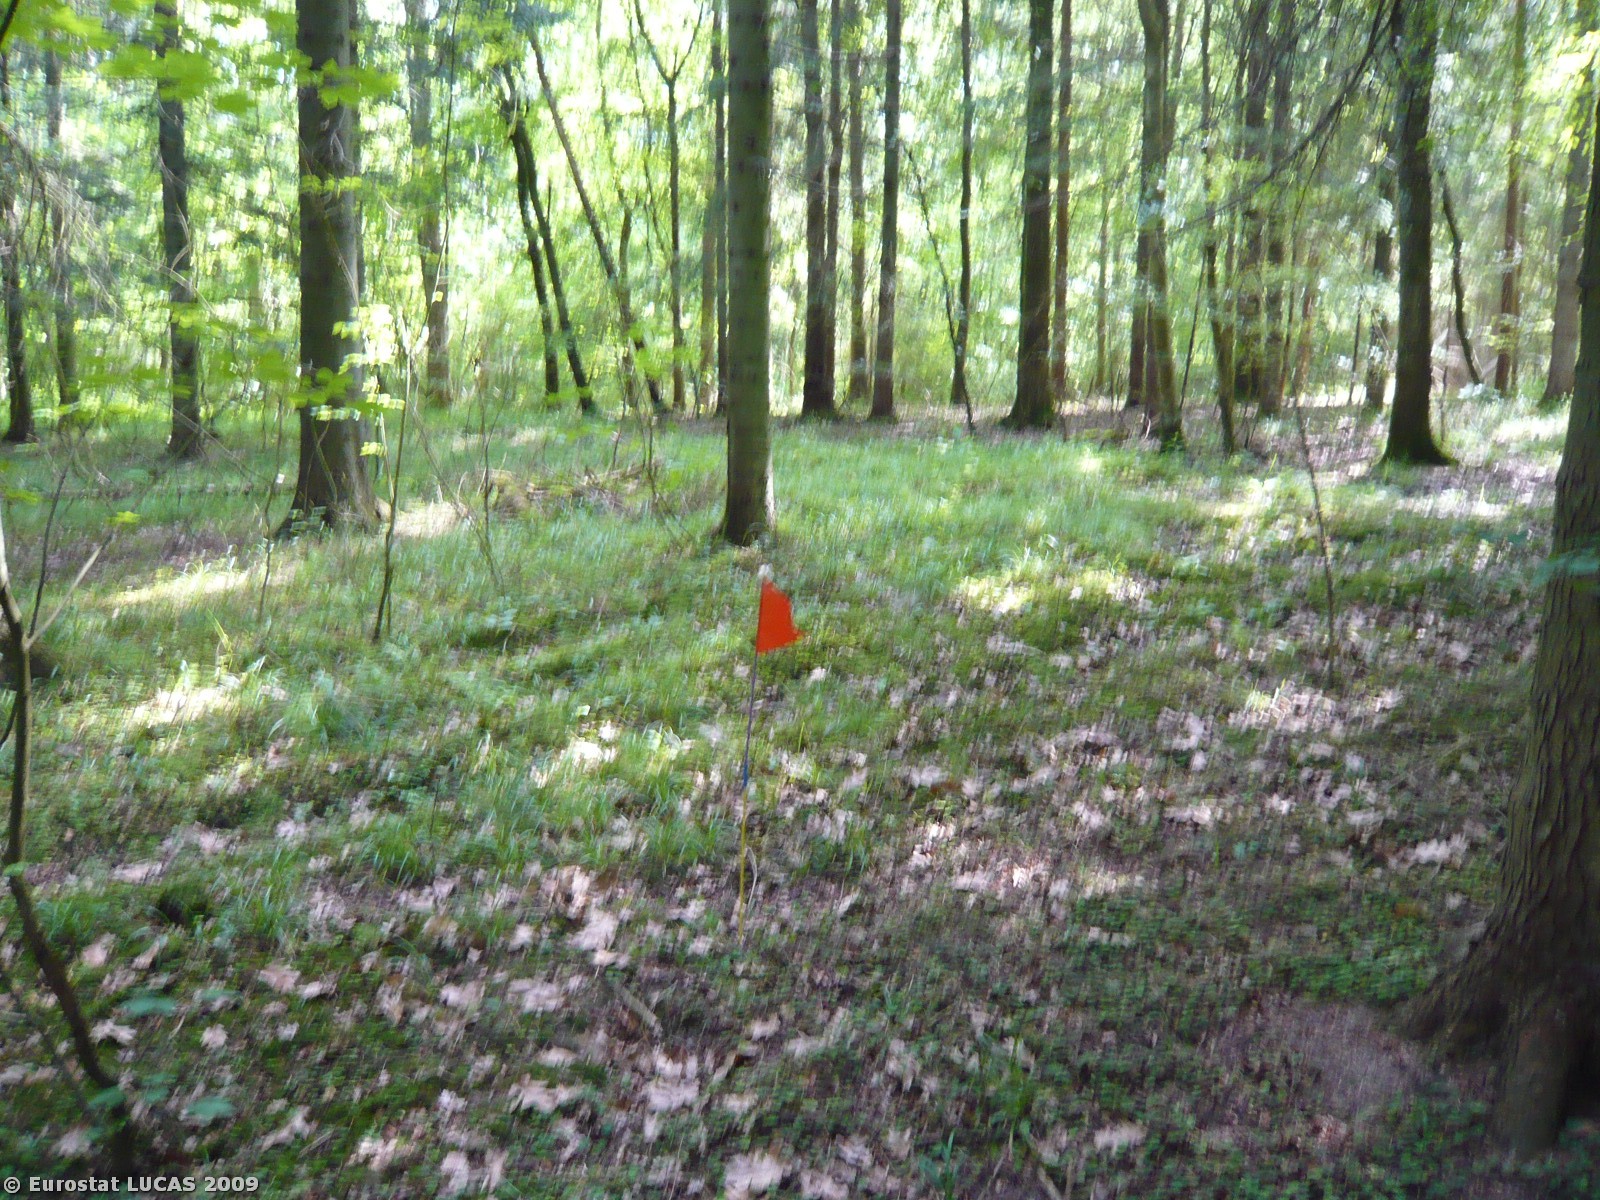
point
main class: Woodland
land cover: Coniferous woodland
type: hemiboreal forest and nemoral coniferous forest and mixed broadleaved-coniferous forest
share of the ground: > 75 %
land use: Forestry
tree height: > 5 m
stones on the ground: < 10 %
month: July
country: DK
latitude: 55.5451
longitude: 11.8527
